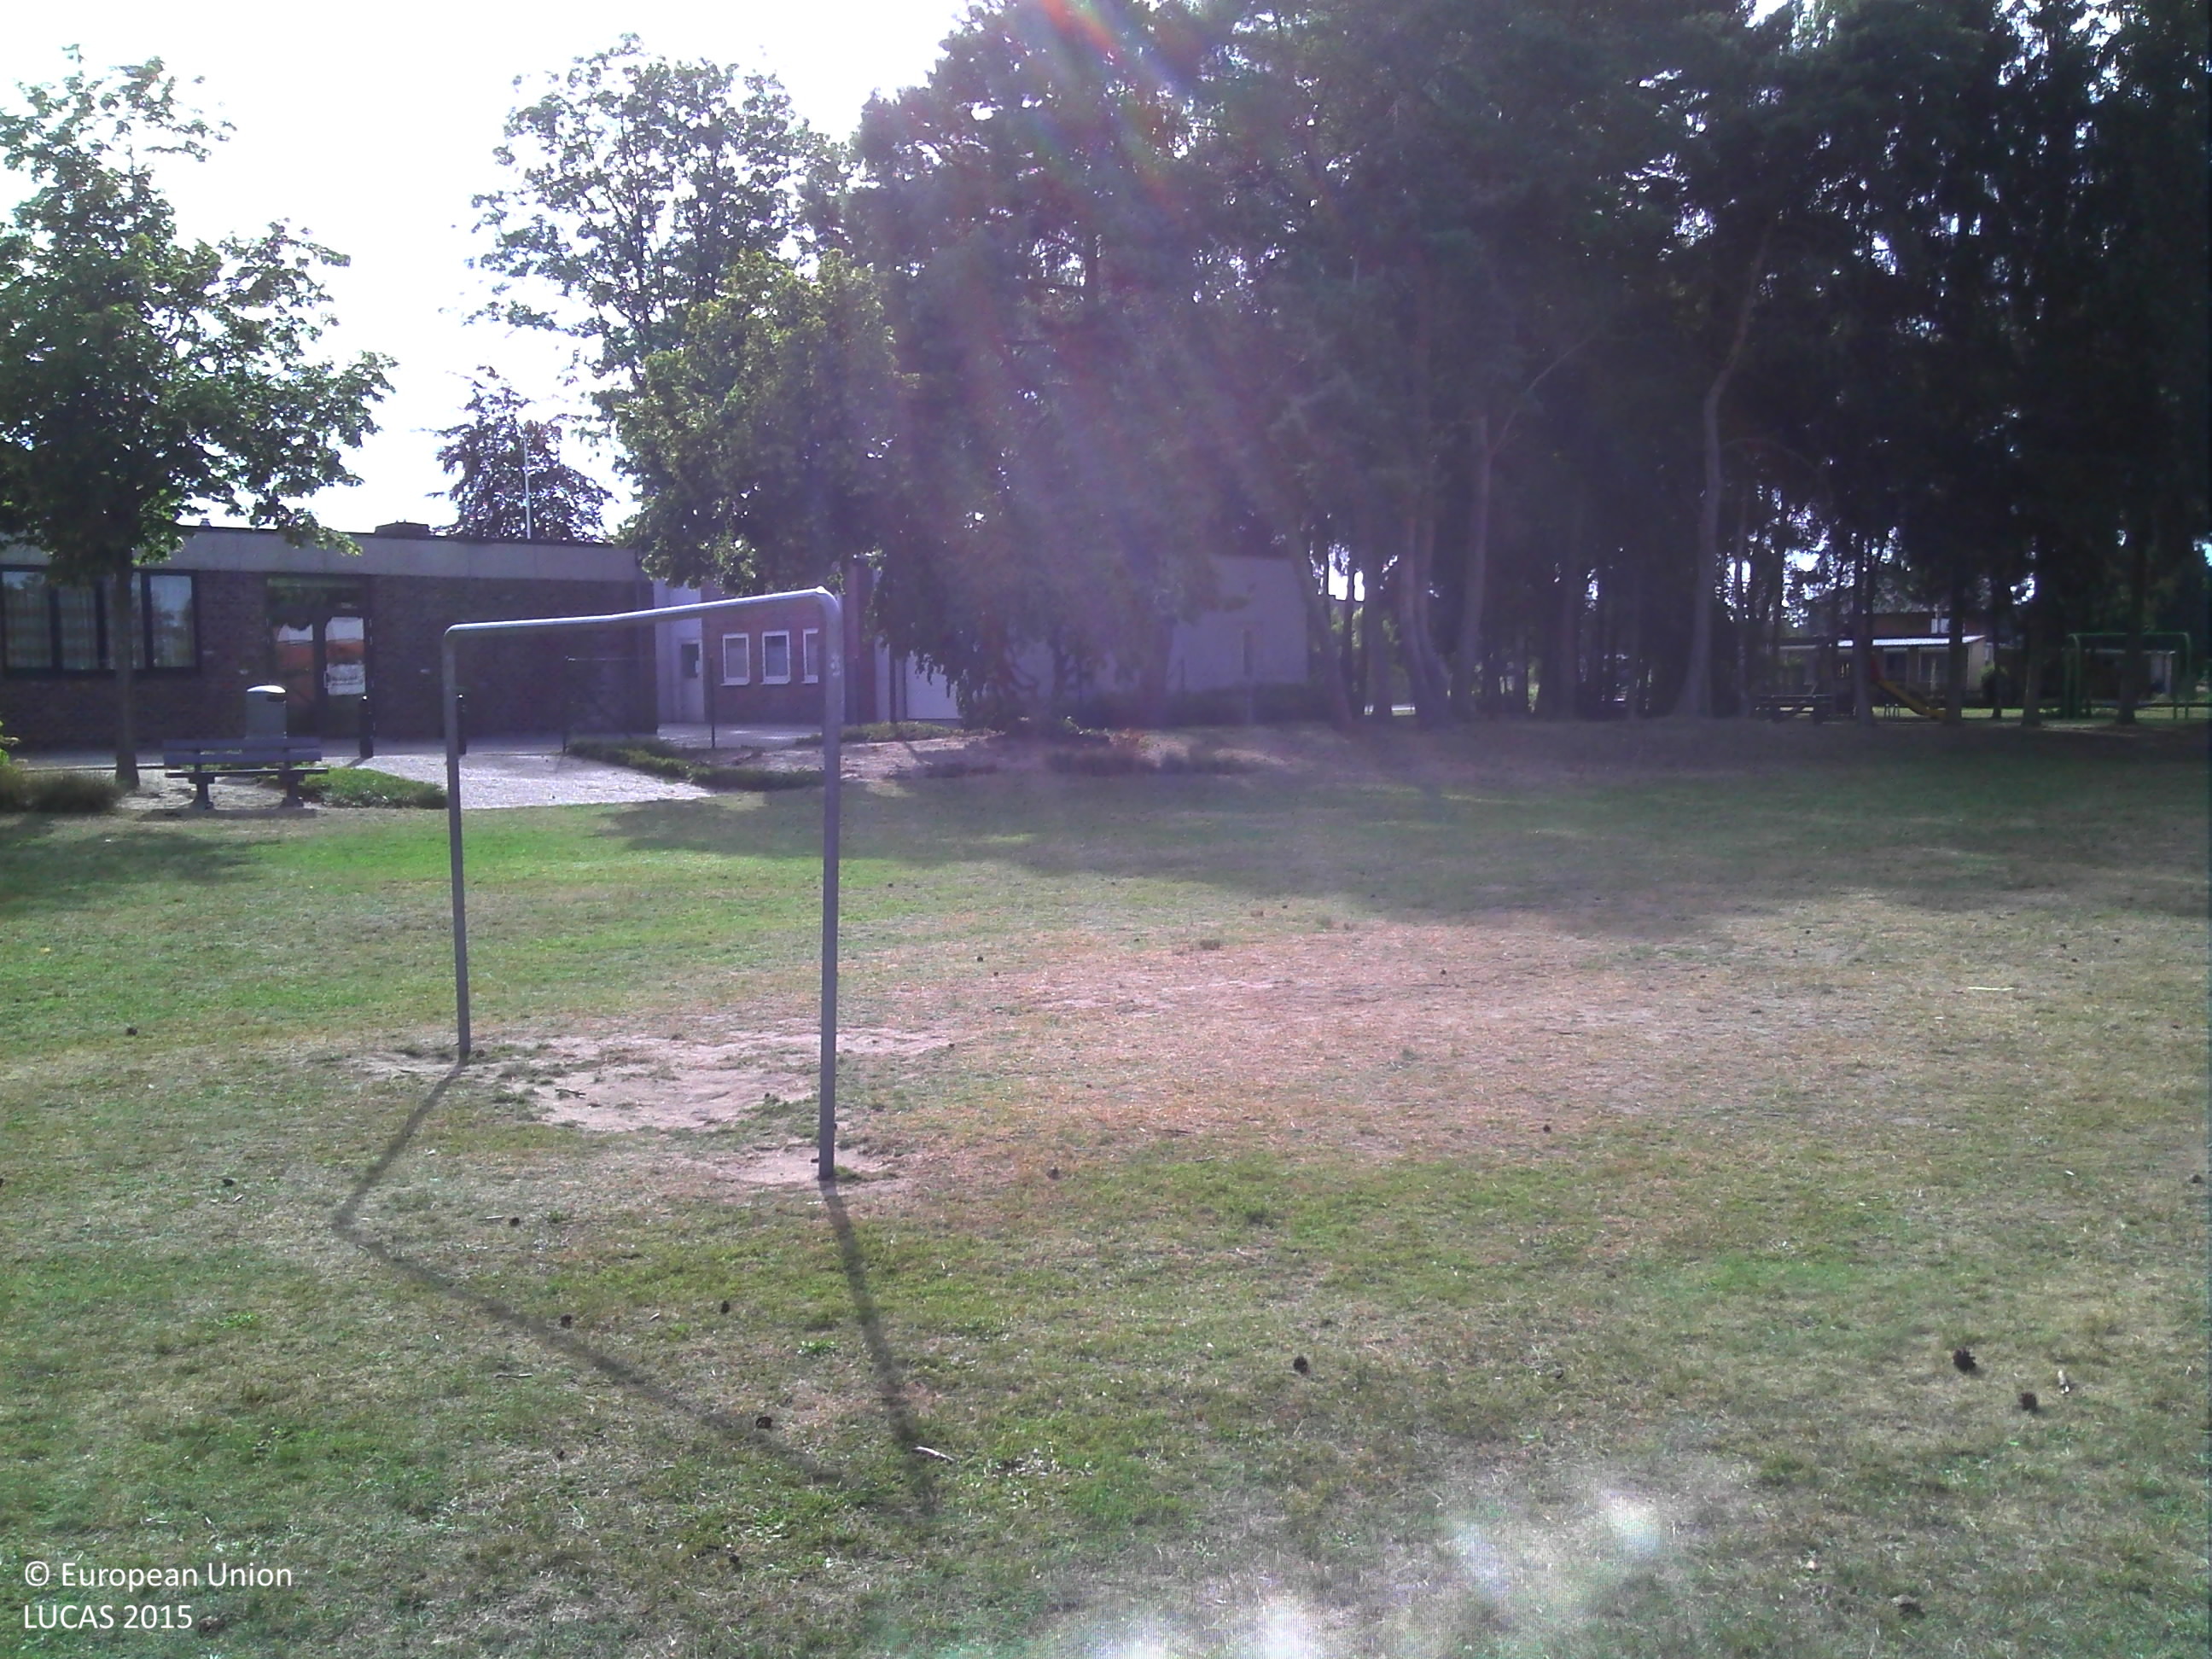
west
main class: Grassland
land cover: Grassland without tree/shrub cover
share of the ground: > 75 %
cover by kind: herbaceous plants 100 %
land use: Amenities, museums, leisure
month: August
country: BE
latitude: 51.1061
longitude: 5.5564
